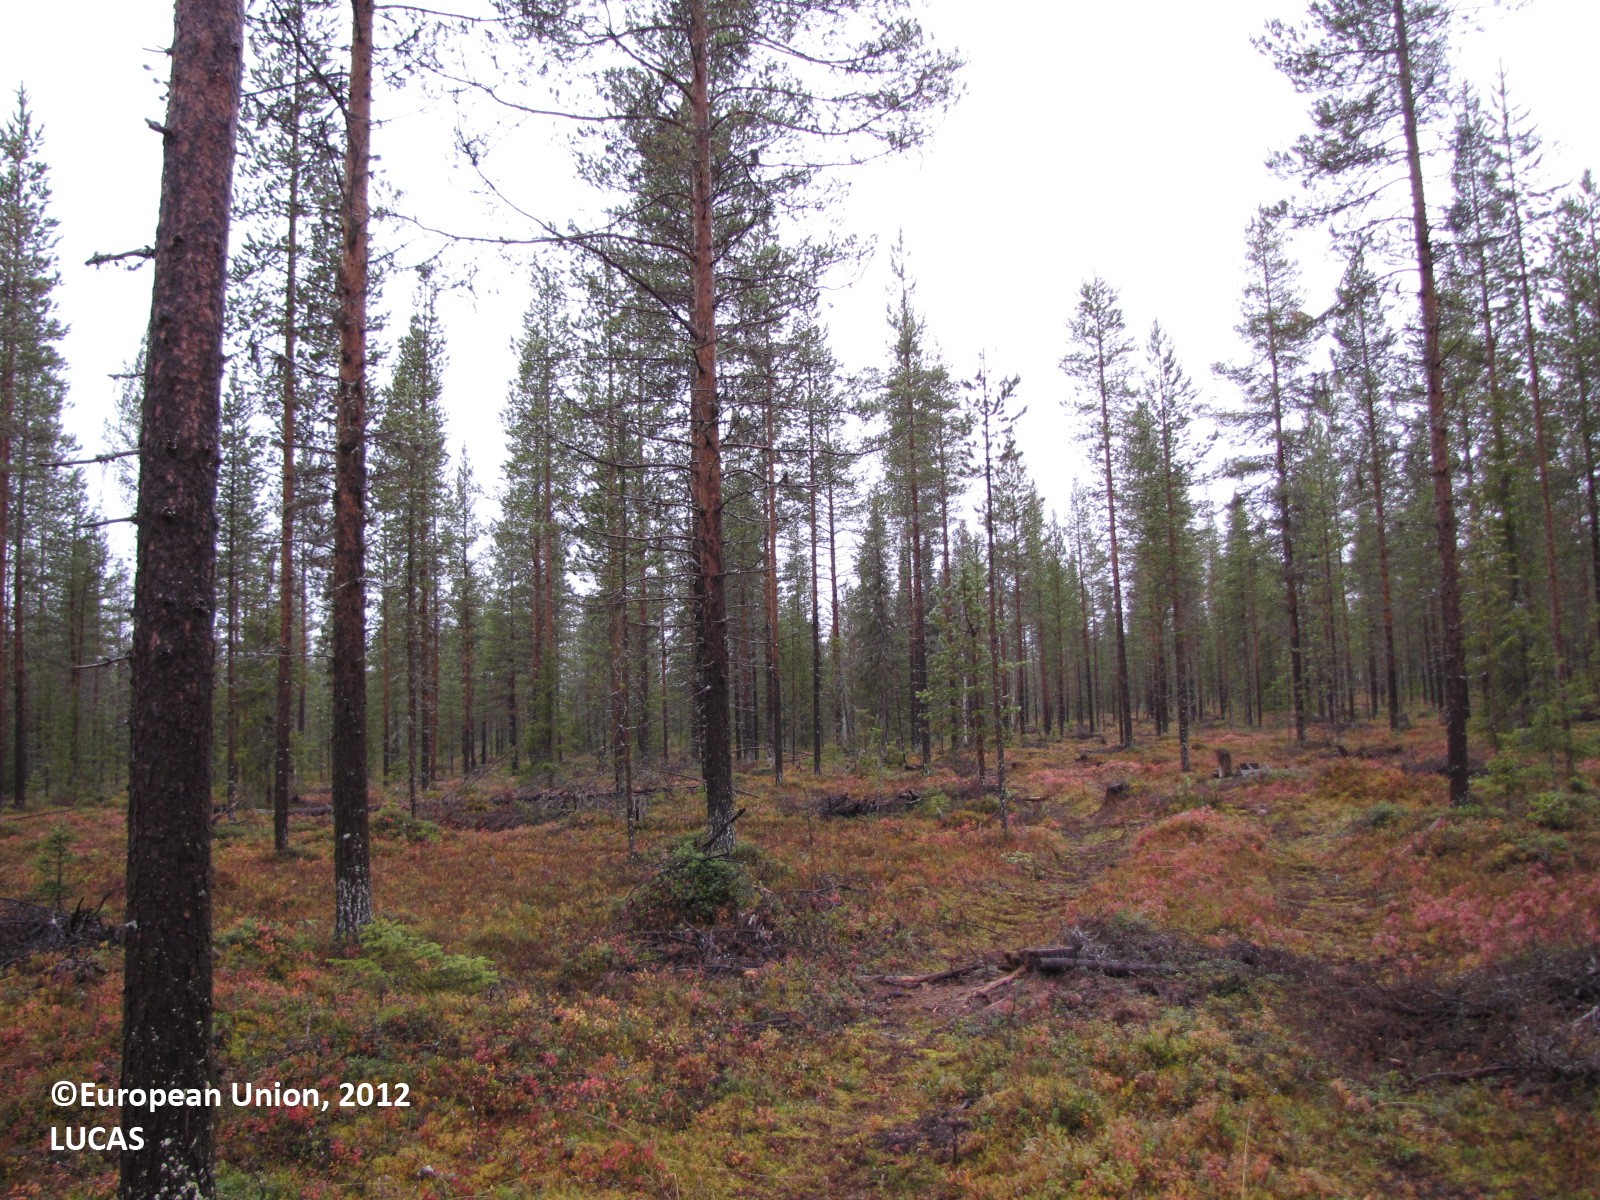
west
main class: Woodland
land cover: Pine dominated coniferous woodland
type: boreal forest
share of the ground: 25 - 50 %
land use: Forestry
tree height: > 5 m
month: September
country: FI
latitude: 67.6440
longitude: 23.5614
